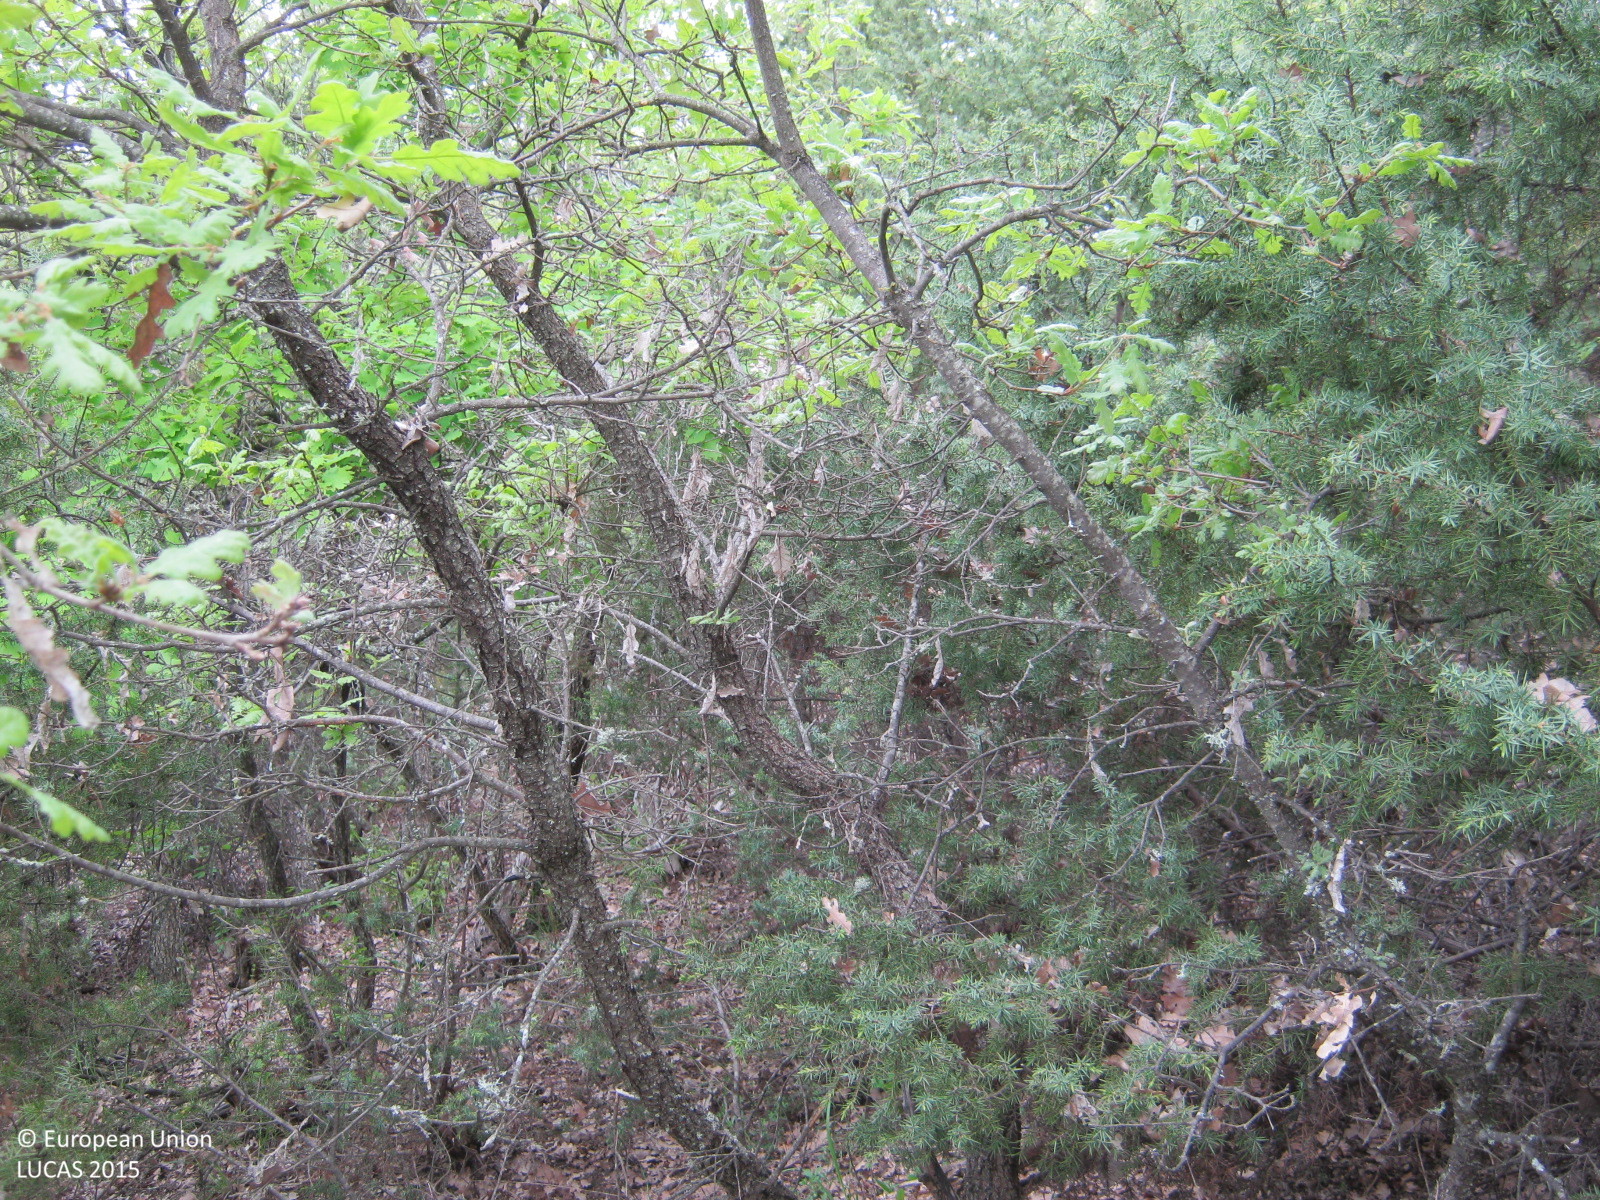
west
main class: Woodland
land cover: Broadleaved woodland
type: thermophilous deciduous forest
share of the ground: > 75 %
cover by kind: broadleaved forest trees 75 %, shrubs 20 %, herbaceous plants 5 %
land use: Forestry
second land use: Other primary production
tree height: > 5 m
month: April
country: GR
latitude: 41.0323
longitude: 23.2298
